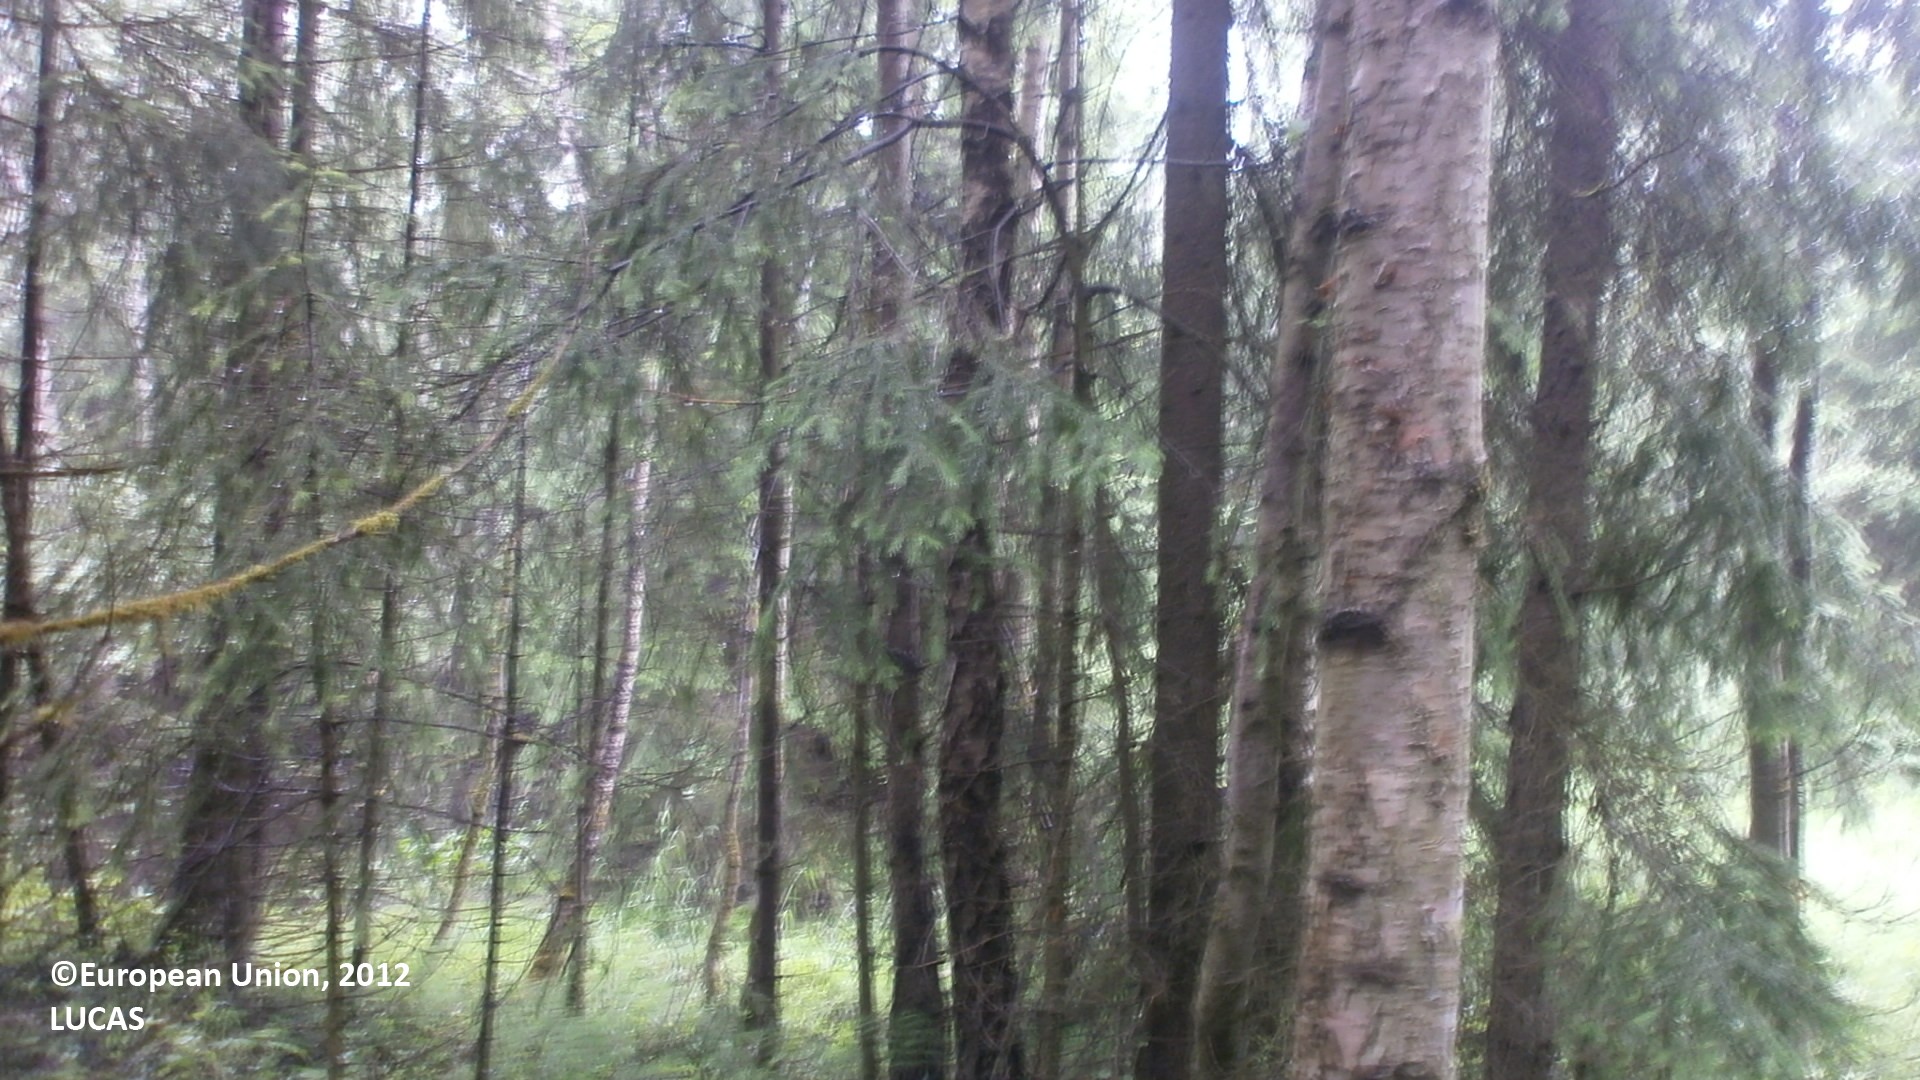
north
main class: Woodland
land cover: Spruce dominated mixed woodland
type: boreal forest
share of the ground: > 75 %
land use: Forestry
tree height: > 5 m
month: July
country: FI
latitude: 64.6537
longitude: 24.4495
